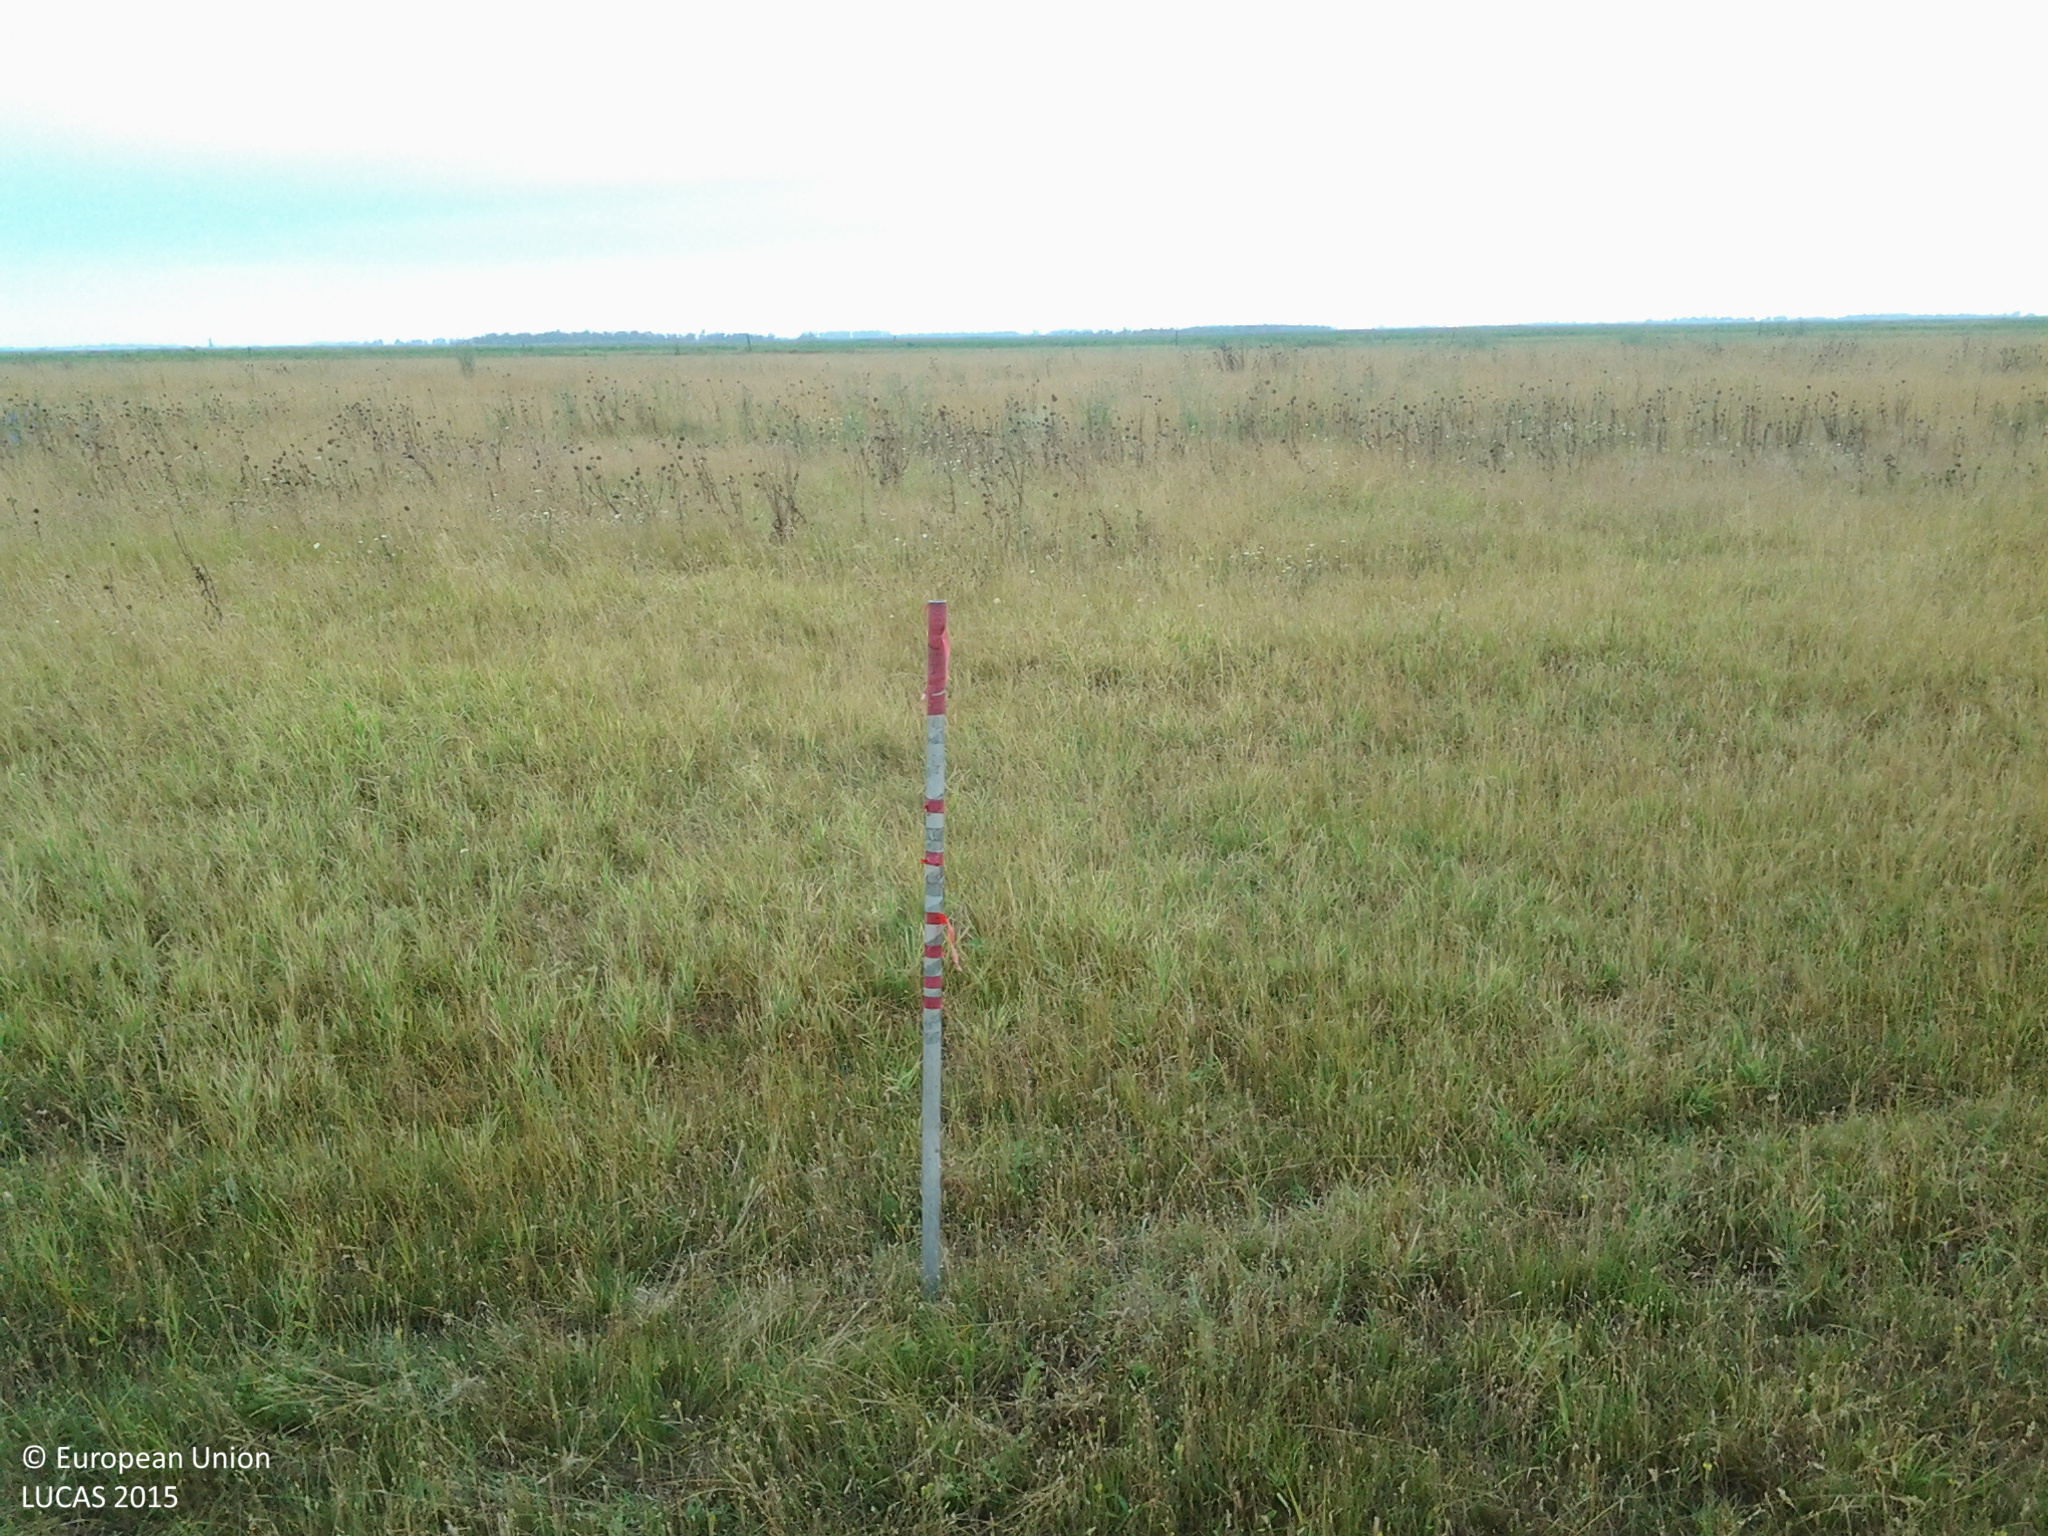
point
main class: Grassland
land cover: Grassland without tree/shrub cover
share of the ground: > 75 %
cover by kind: herbaceous plants 100 %
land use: Agriculture (excluding fallow land and kitchen gardens)
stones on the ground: < 10 %
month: July
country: HU
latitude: 47.0821
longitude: 19.1447
